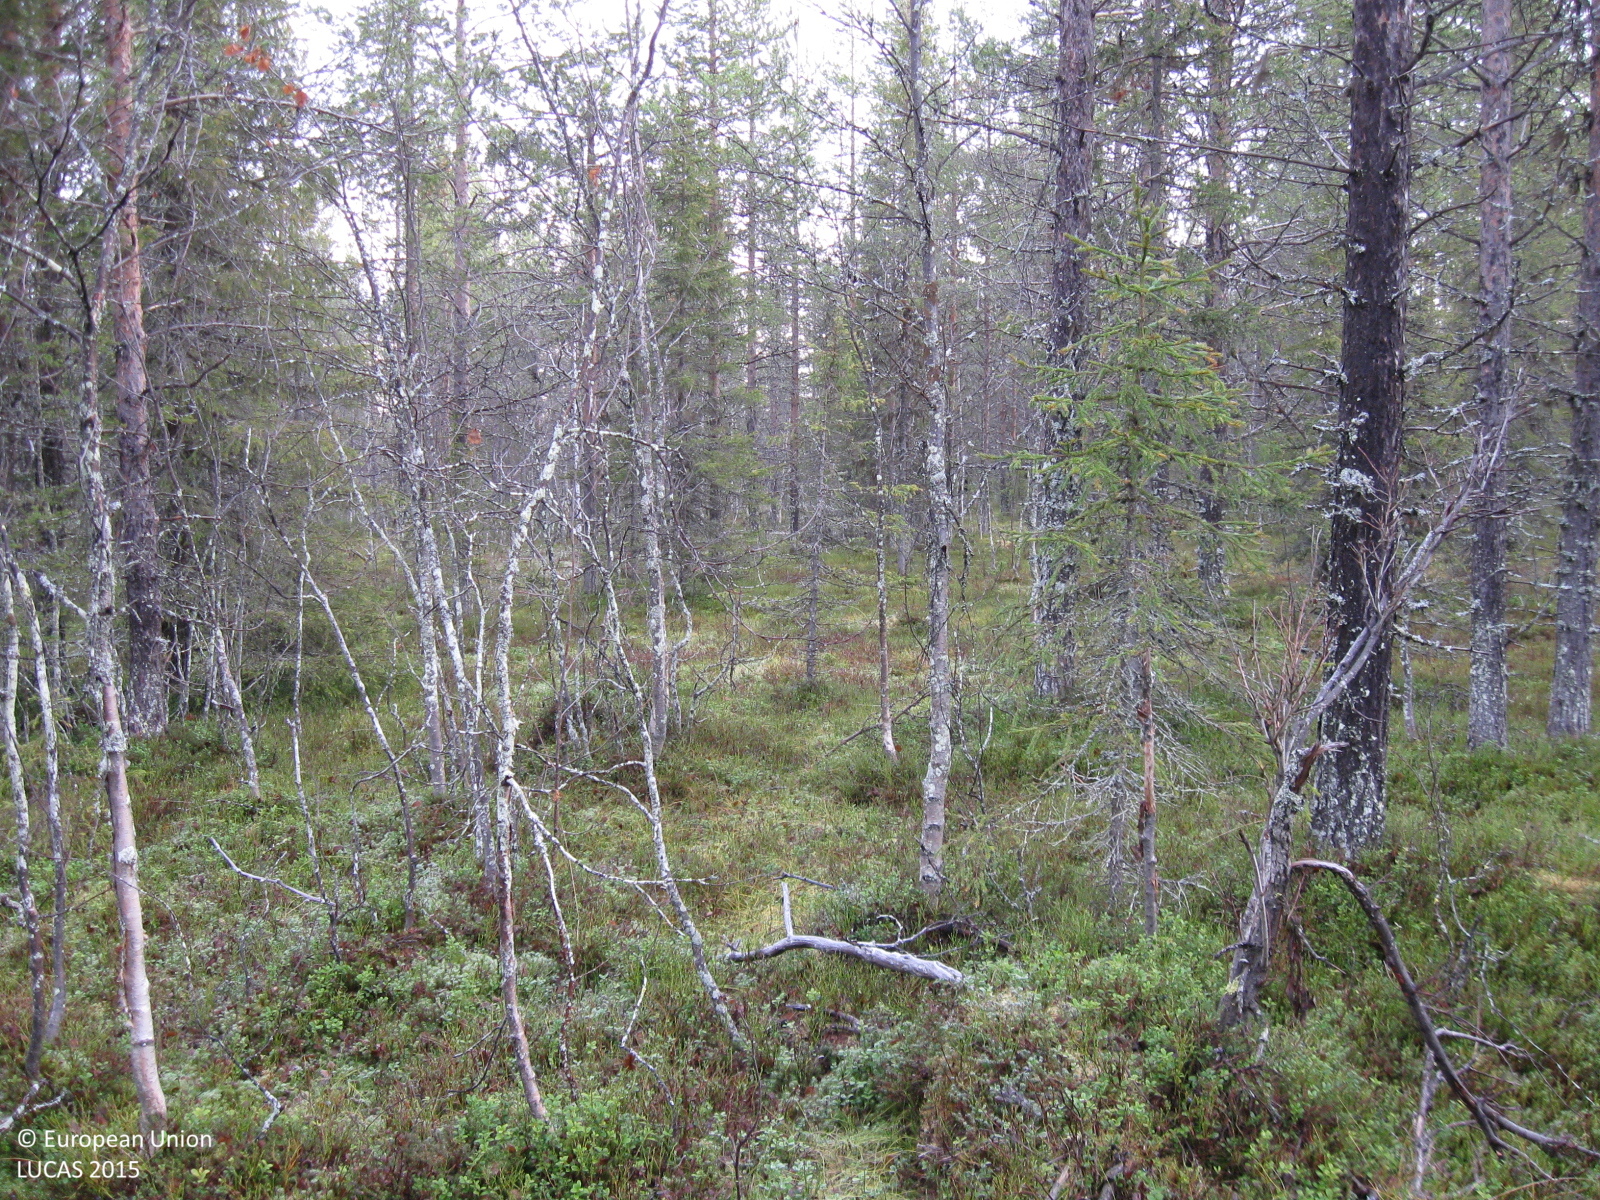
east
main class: Woodland
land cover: Pine dominated coniferous woodland
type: boreal forest
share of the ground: 50 - 75 %
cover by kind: coniferous forest trees 60 %, shrubs 15 %, broadleaved forest trees 10 %, lichens and mosses 10 %, herbaceous plants 5 %
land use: Forestry
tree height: > 5 m
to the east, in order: Pine dominated coniferous woodland; Pine dominated mixed woodland; Pine dominated coniferous woodland; Pine dominated mixed woodland; Other mixed woodland
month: October
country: SE
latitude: 66.5238
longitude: 21.5024
